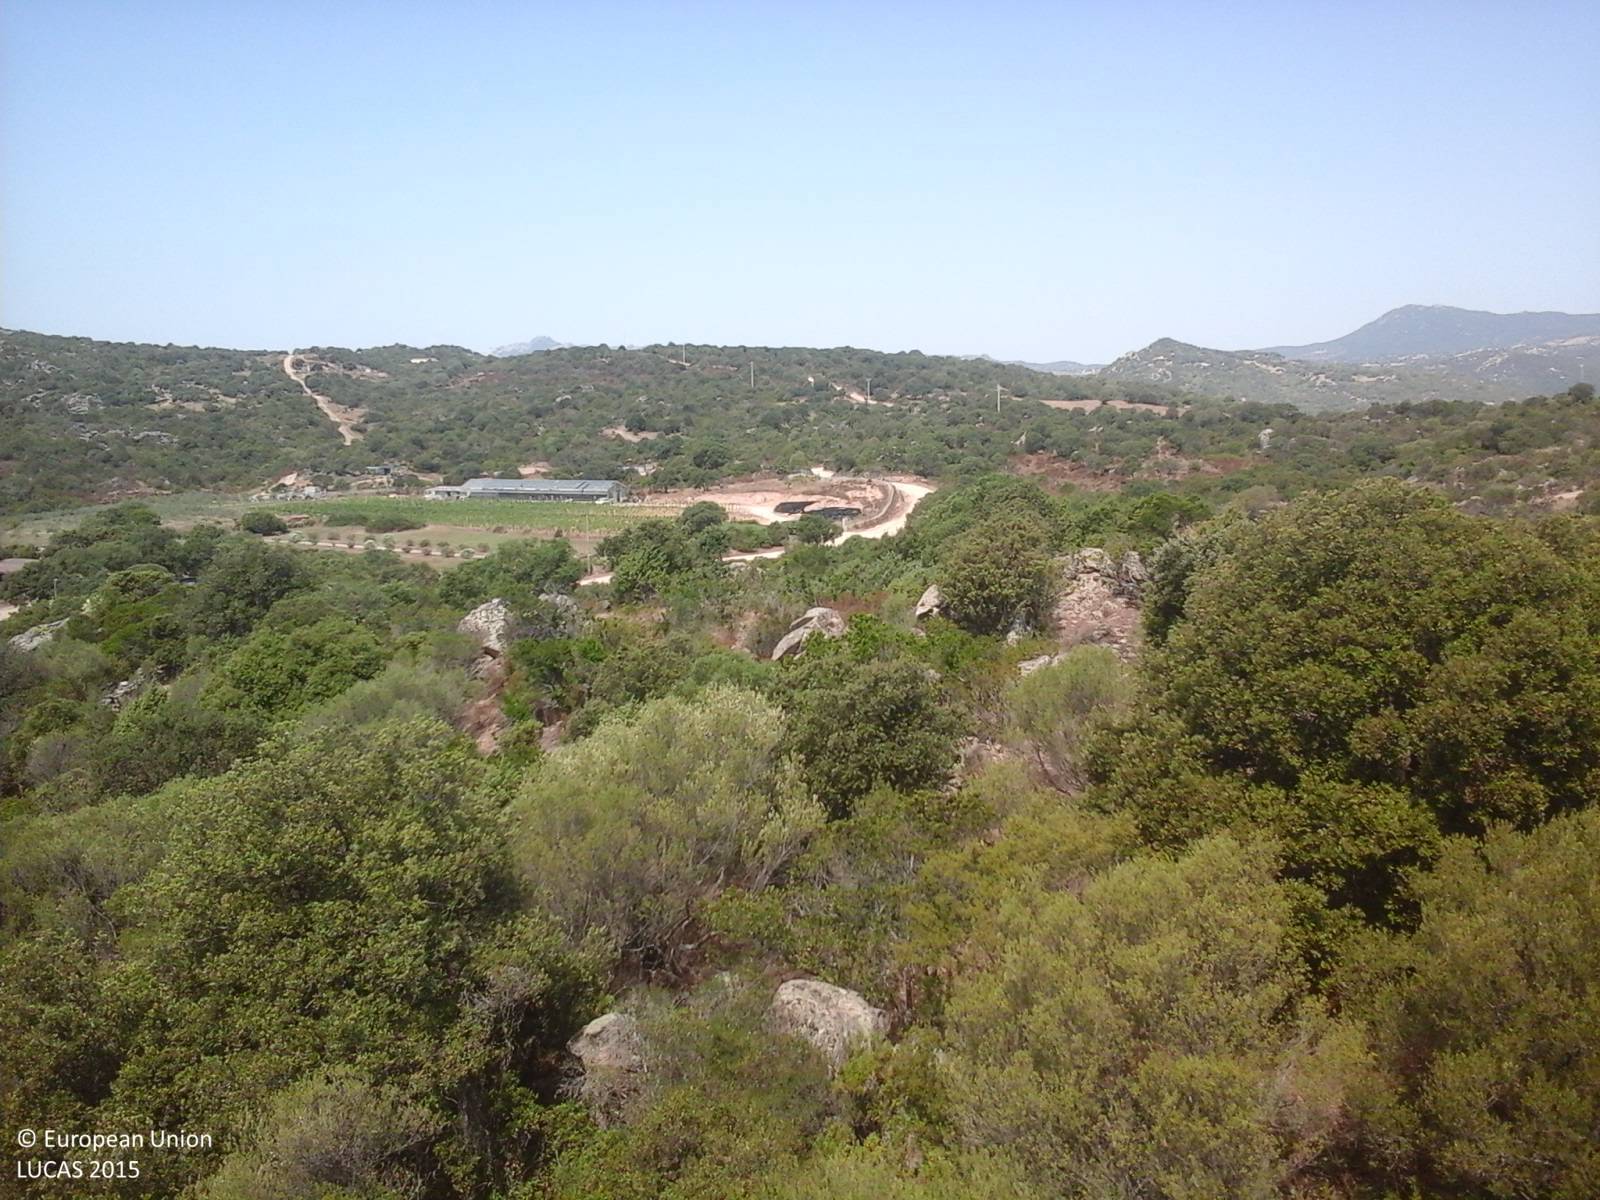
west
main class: Woodland
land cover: Broadleaved woodland
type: broadleaved evergreen forest
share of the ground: > 75 %
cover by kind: broadleaved forest trees 95 %, consolidated bare surface 5 %
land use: Semi-natural and natural areas not in use
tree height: > 5 m
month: July
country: IT
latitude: 40.8990
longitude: 9.4211
